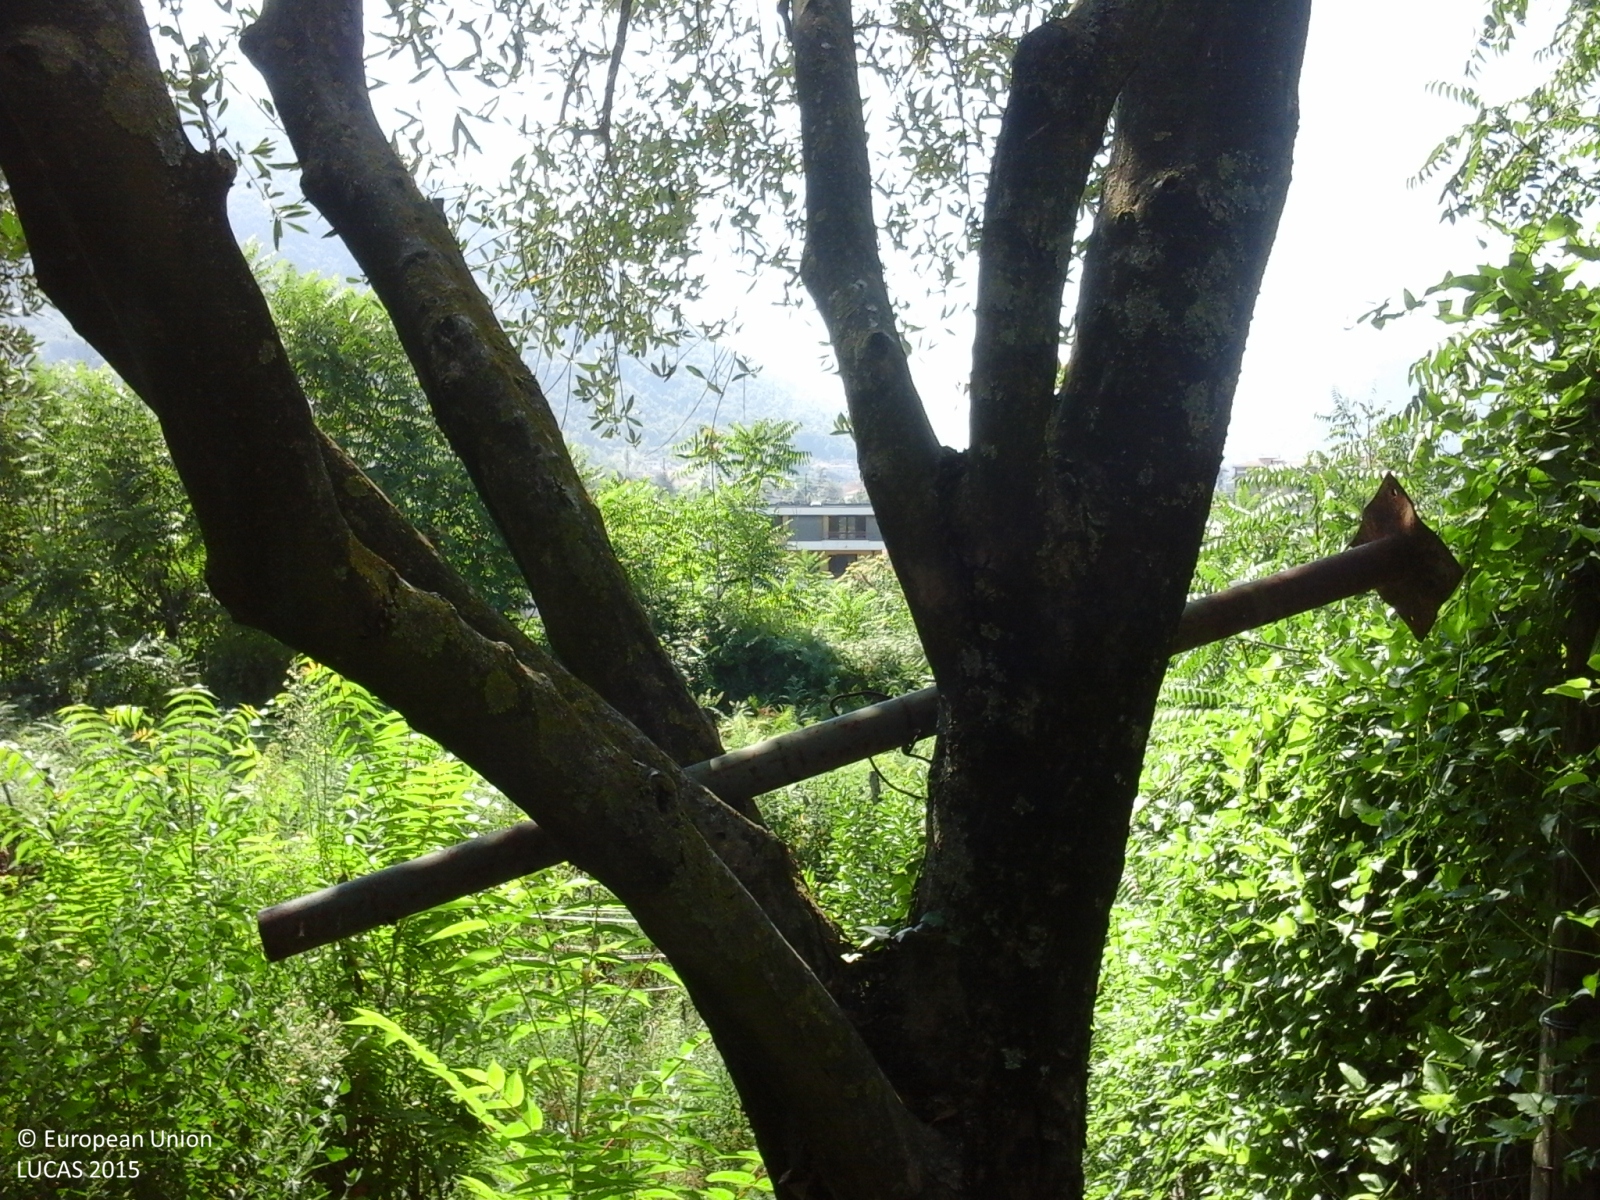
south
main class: Woodland
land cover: Broadleaved woodland
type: exotic forest
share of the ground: > 75 %
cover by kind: broadleaved forest trees 100 %
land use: Semi-natural and natural areas not in use
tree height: > 5 m
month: August
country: IT
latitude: 40.7536
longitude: 14.6829
